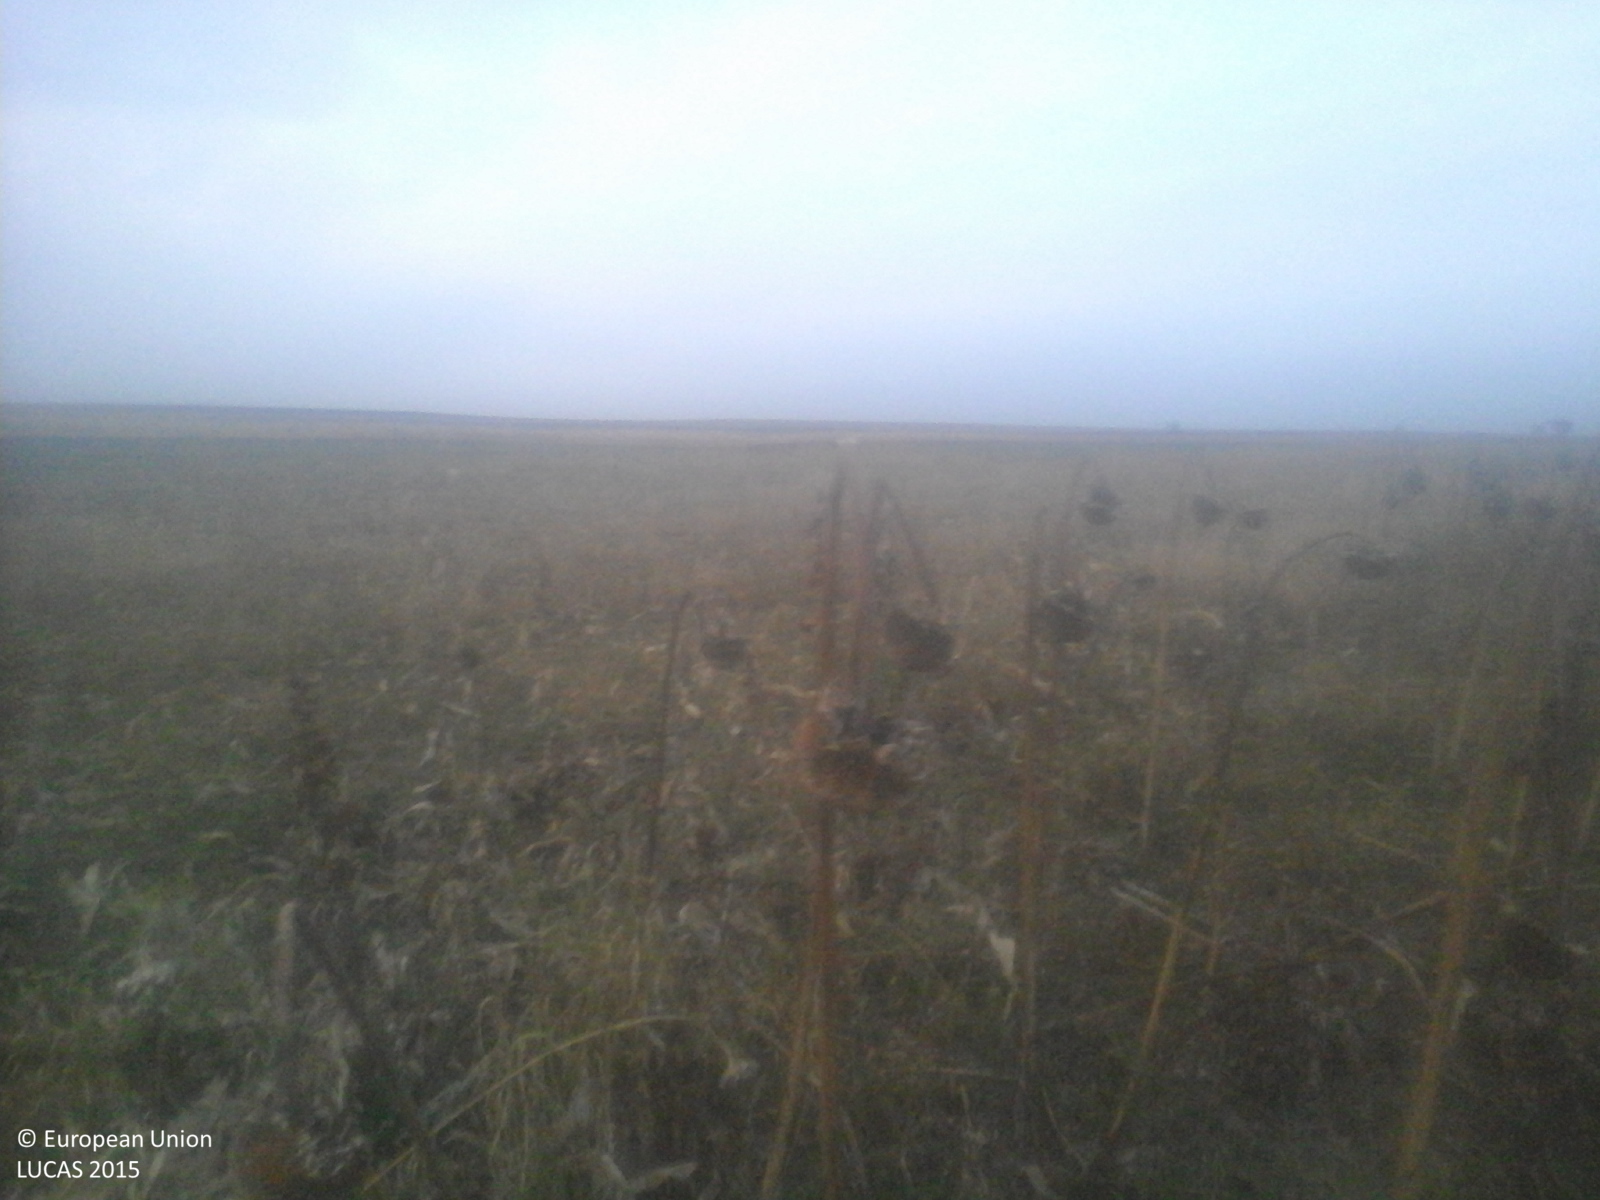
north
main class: Cropland
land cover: Sunflower
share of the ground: 25 - 50 %
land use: Agriculture (excluding fallow land and kitchen gardens)
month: October
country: RO
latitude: 45.3580
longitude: 26.9223
